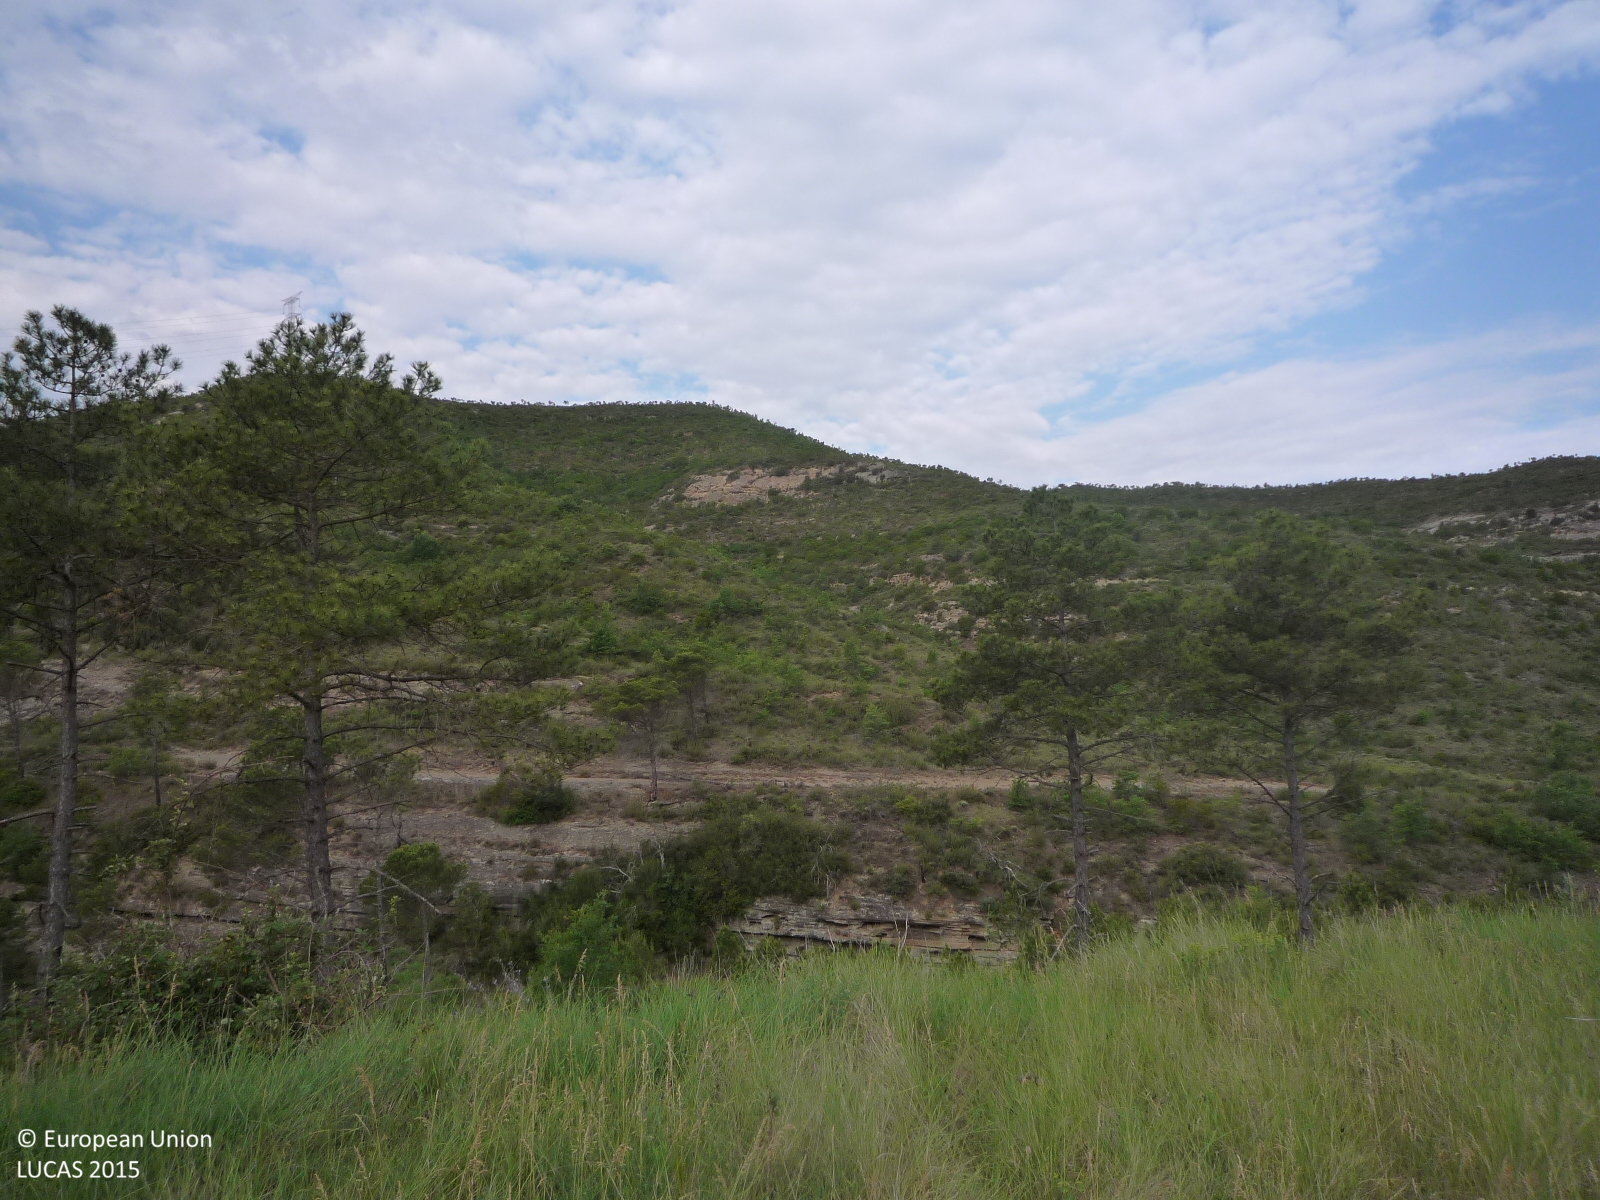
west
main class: Grassland
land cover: Grassland with sparse tree/shrub cover
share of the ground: > 75 %
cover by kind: herbaceous plants 95 %, coniferous forest trees 5 %
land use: Semi-natural and natural areas not in use
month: June
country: ES
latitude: 41.7400
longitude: 2.0196
